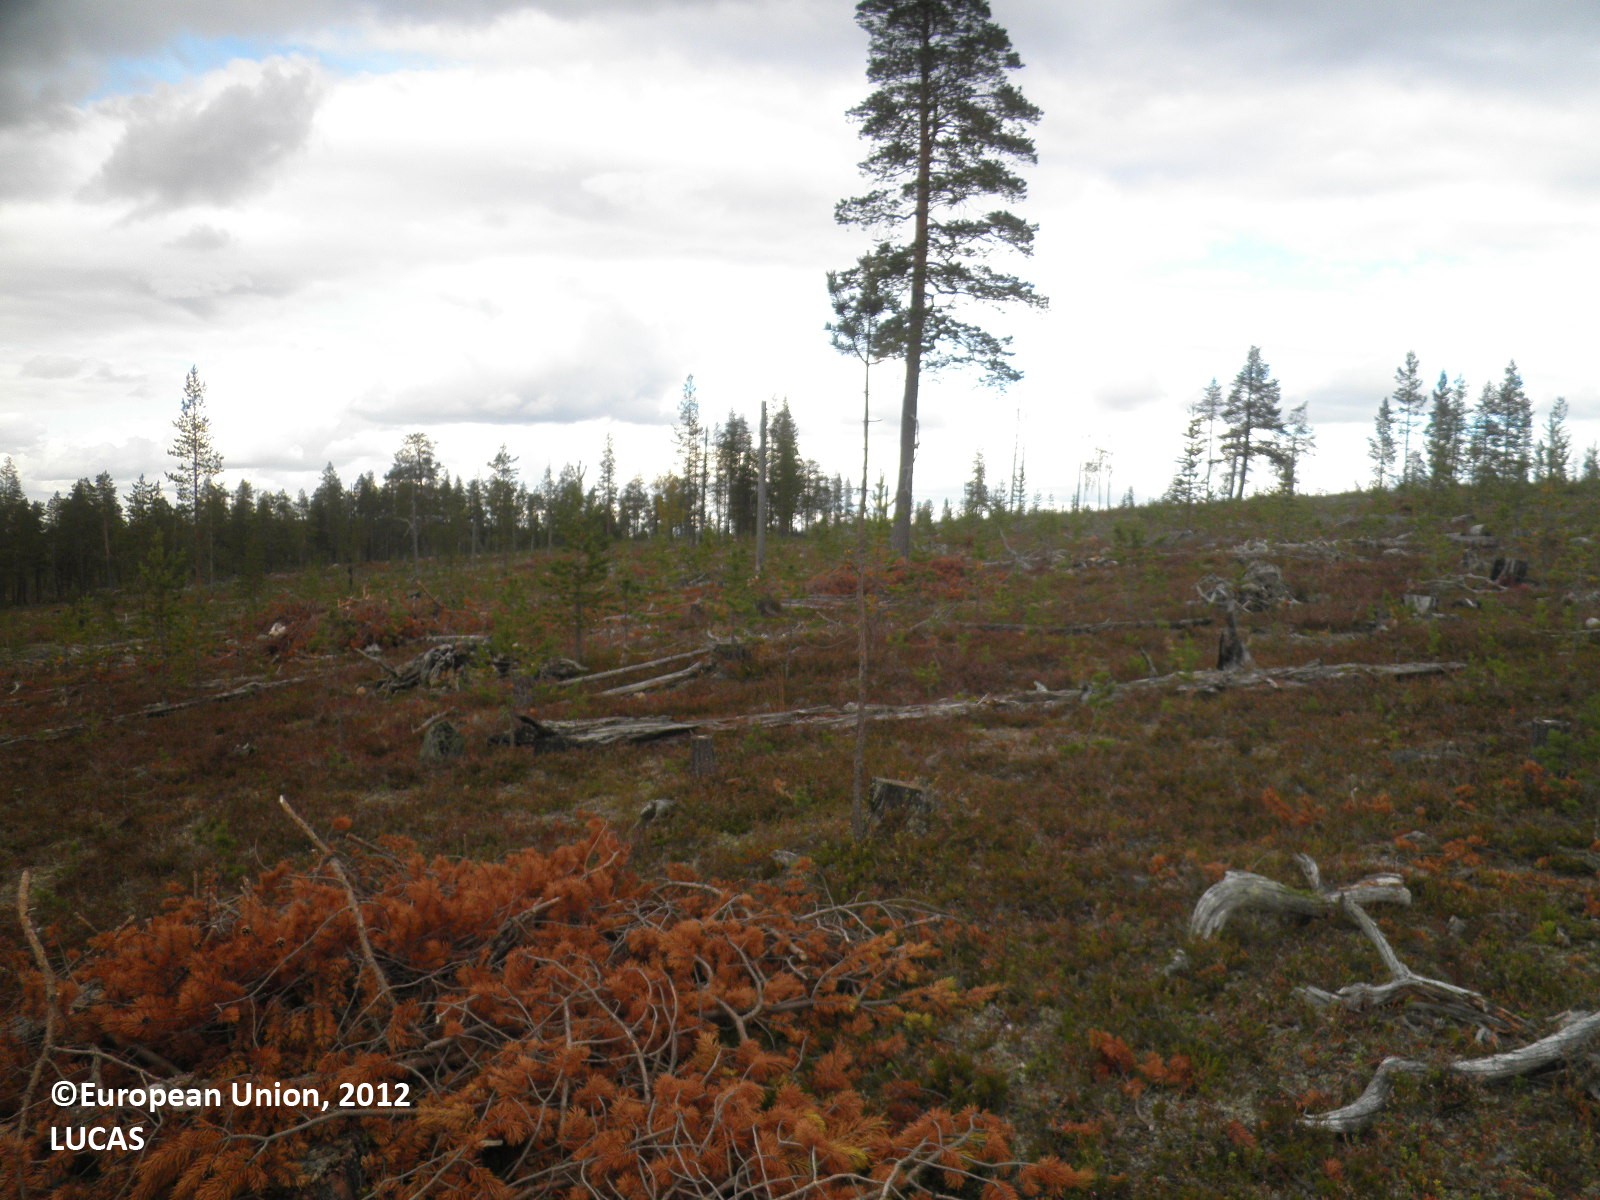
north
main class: Woodland
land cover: Pine dominated coniferous woodland
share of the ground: 10 - 25 %
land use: Forestry
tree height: < 5 m
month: August
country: FI
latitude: 67.9261
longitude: 28.2588
